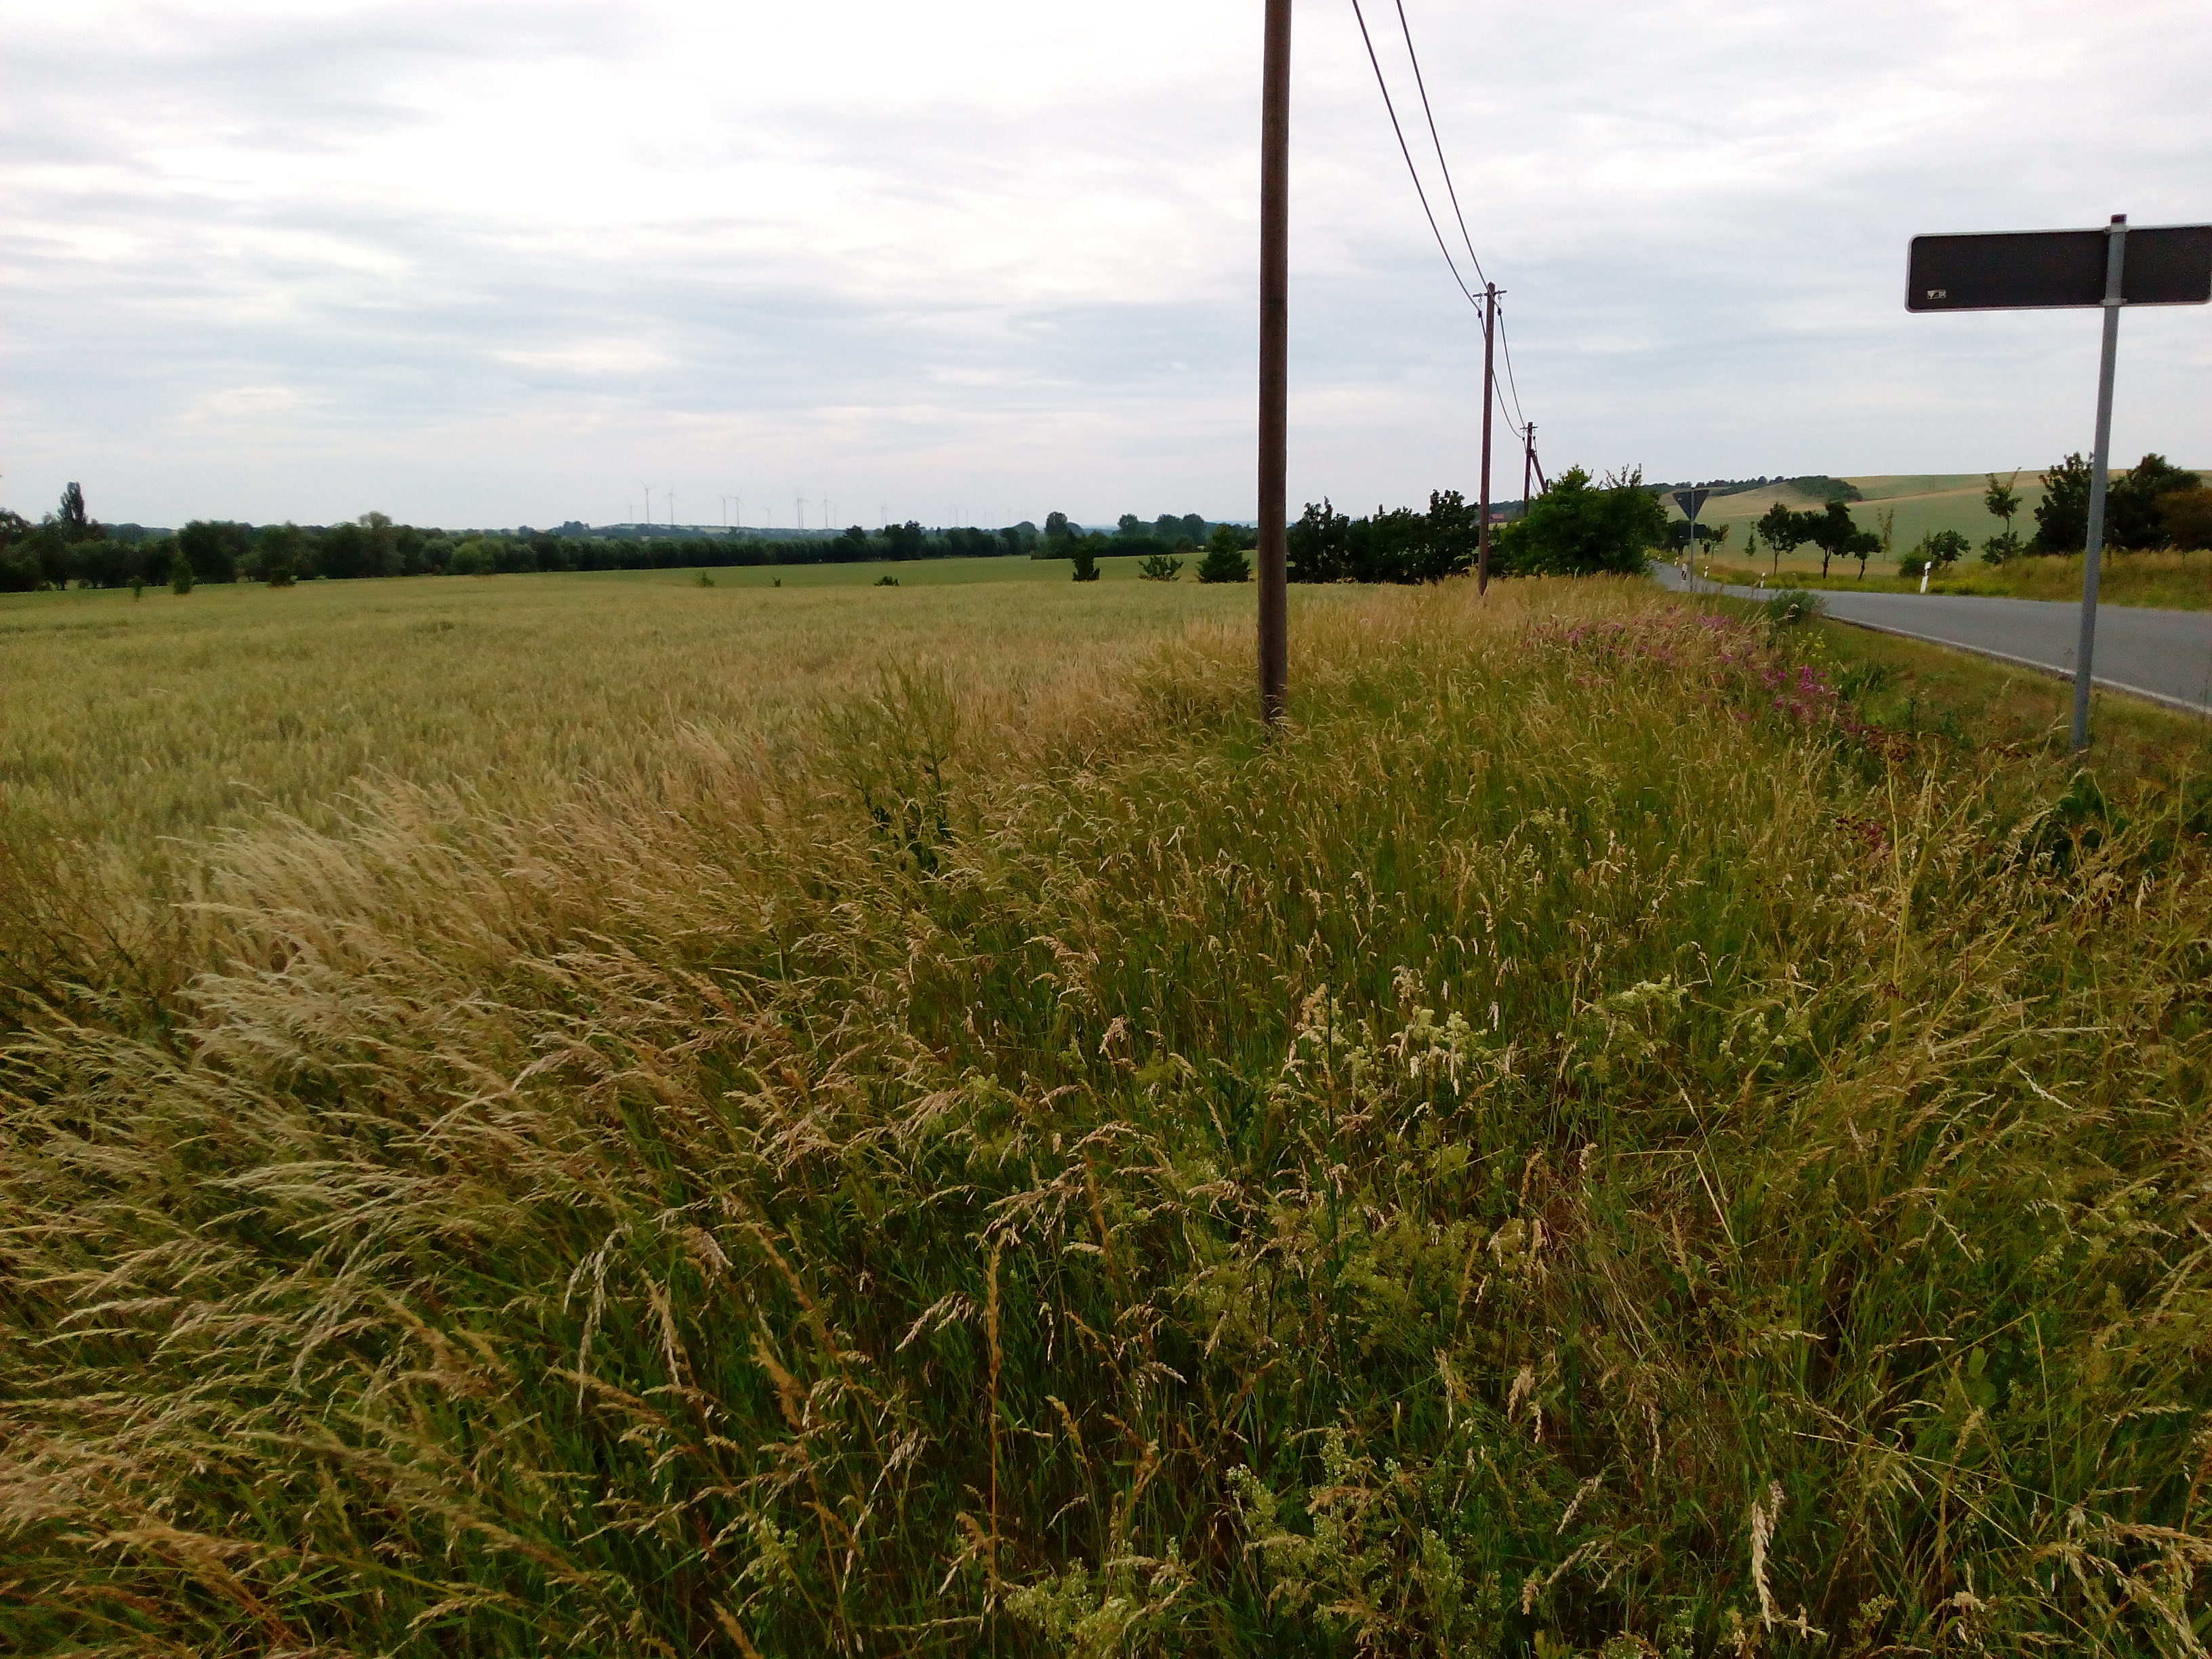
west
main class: Grassland
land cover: Grassland without tree/shrub cover
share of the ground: > 75 %
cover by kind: herbaceous plants 95 %, shrubs 5 %
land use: Agriculture (excluding fallow land and kitchen gardens)
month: June
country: DE
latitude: 51.2221
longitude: 11.0736
